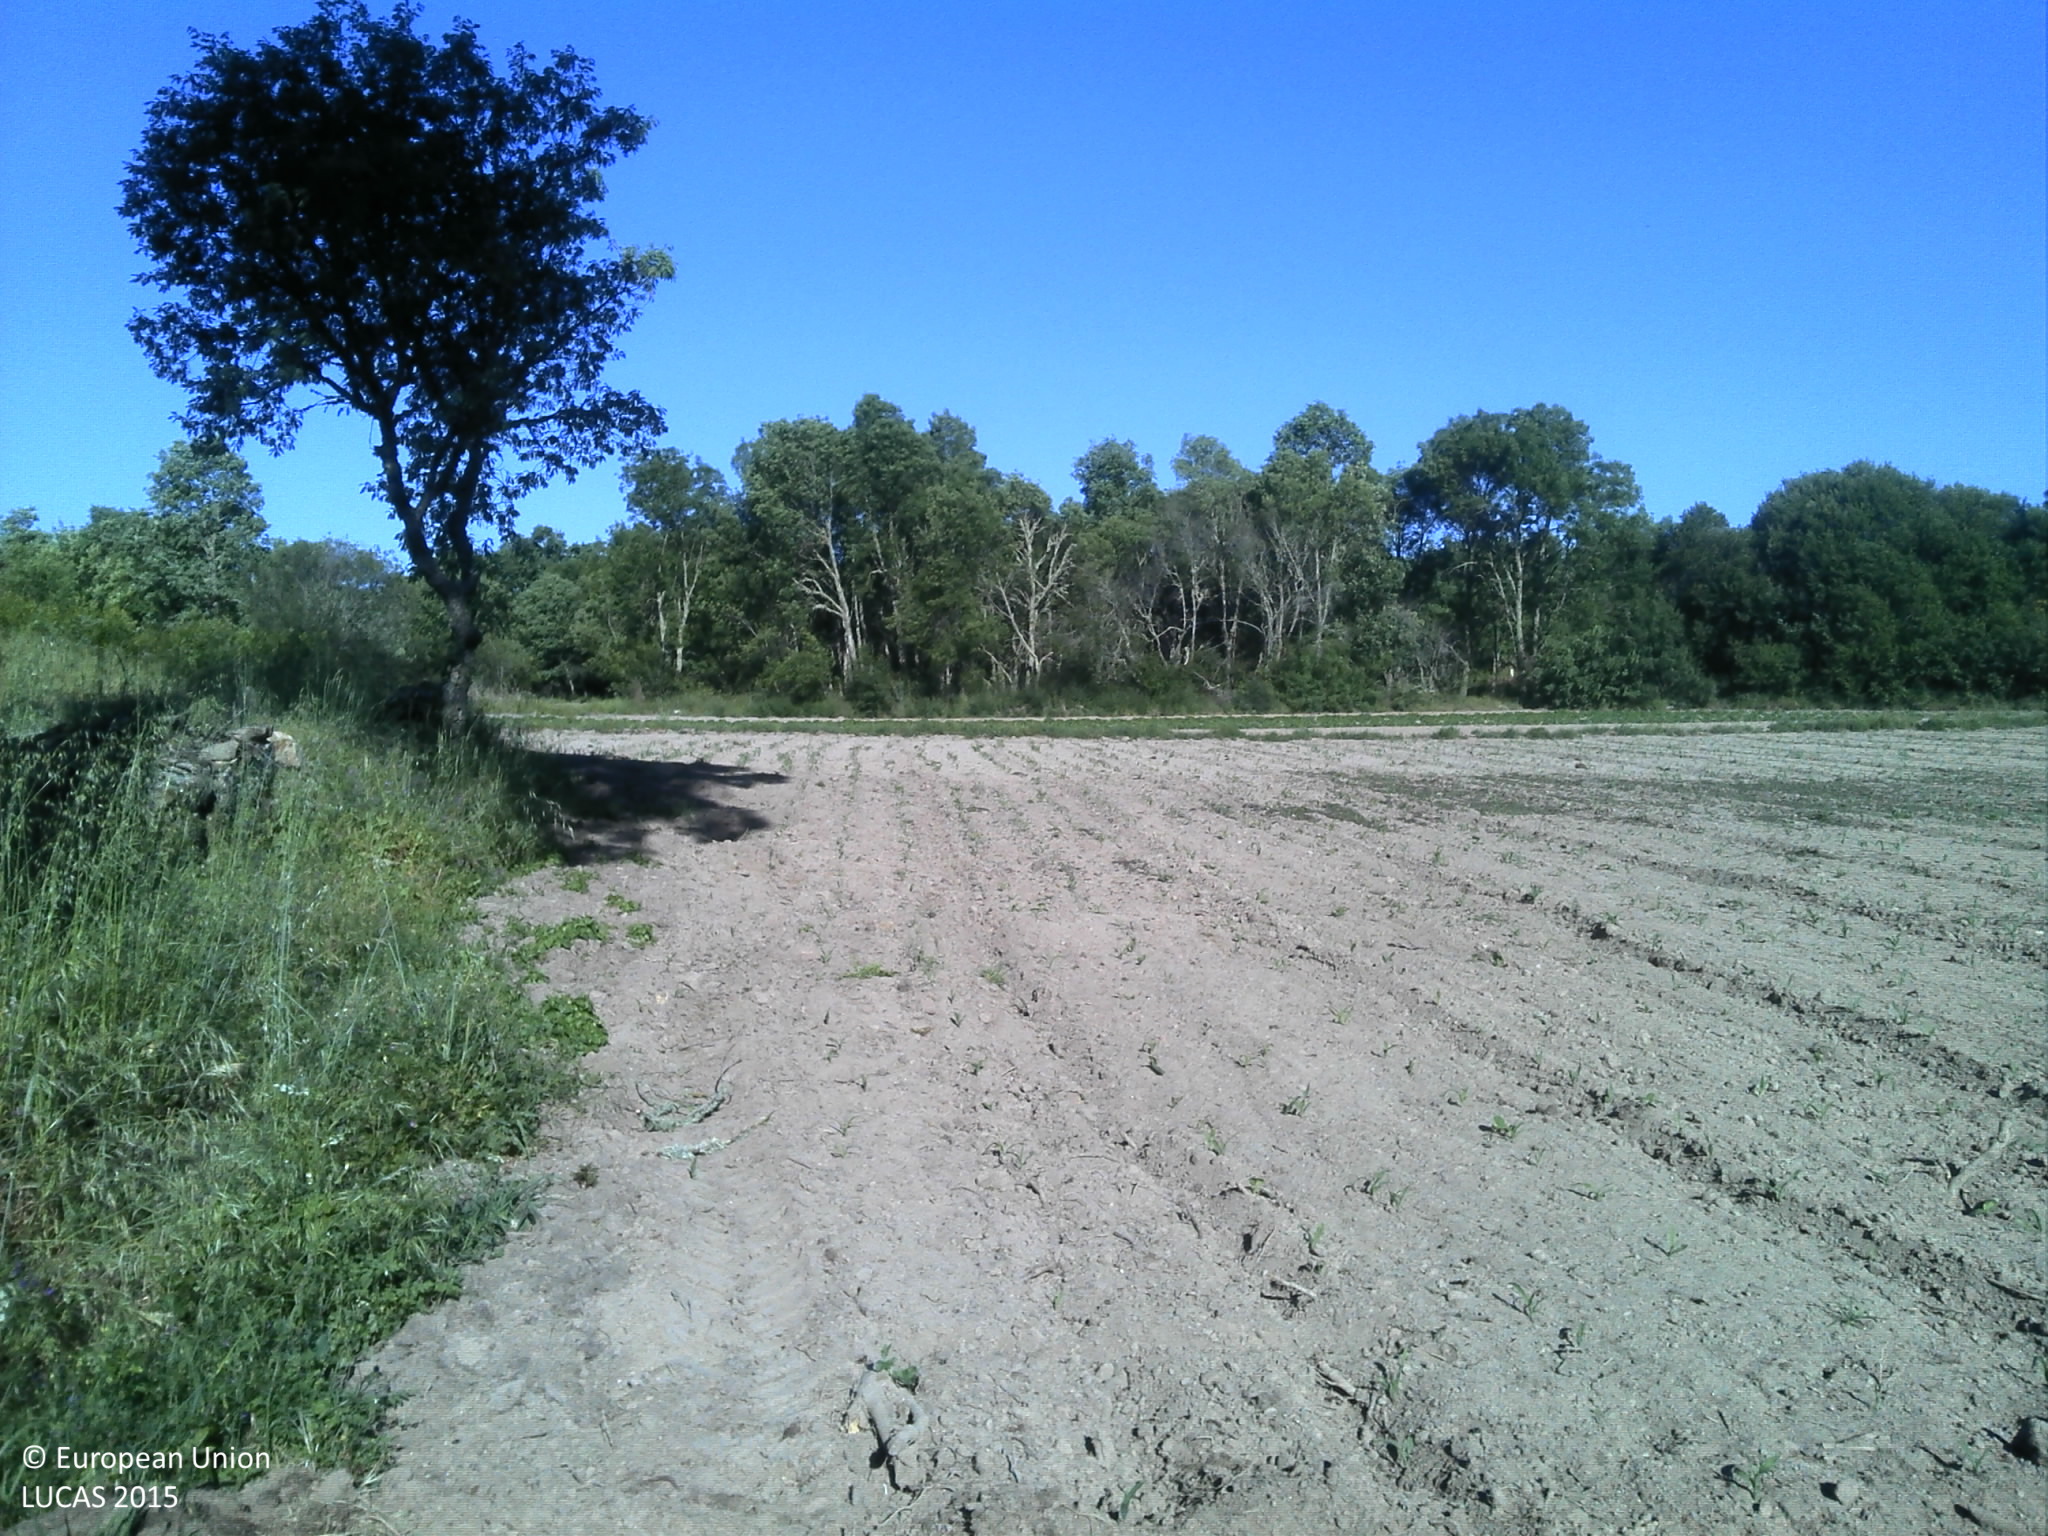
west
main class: Grassland
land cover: Grassland with sparse tree/shrub cover
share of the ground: 25 - 50 %
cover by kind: herbaceous plants 65 %, unconsolidated bare surface 25 %, broadleaved forest trees 5 %, shrubs 5 %
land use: Agriculture (excluding fallow land and kitchen gardens)
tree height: < 5 m
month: May
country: PT
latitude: 40.6448
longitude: -7.1448
